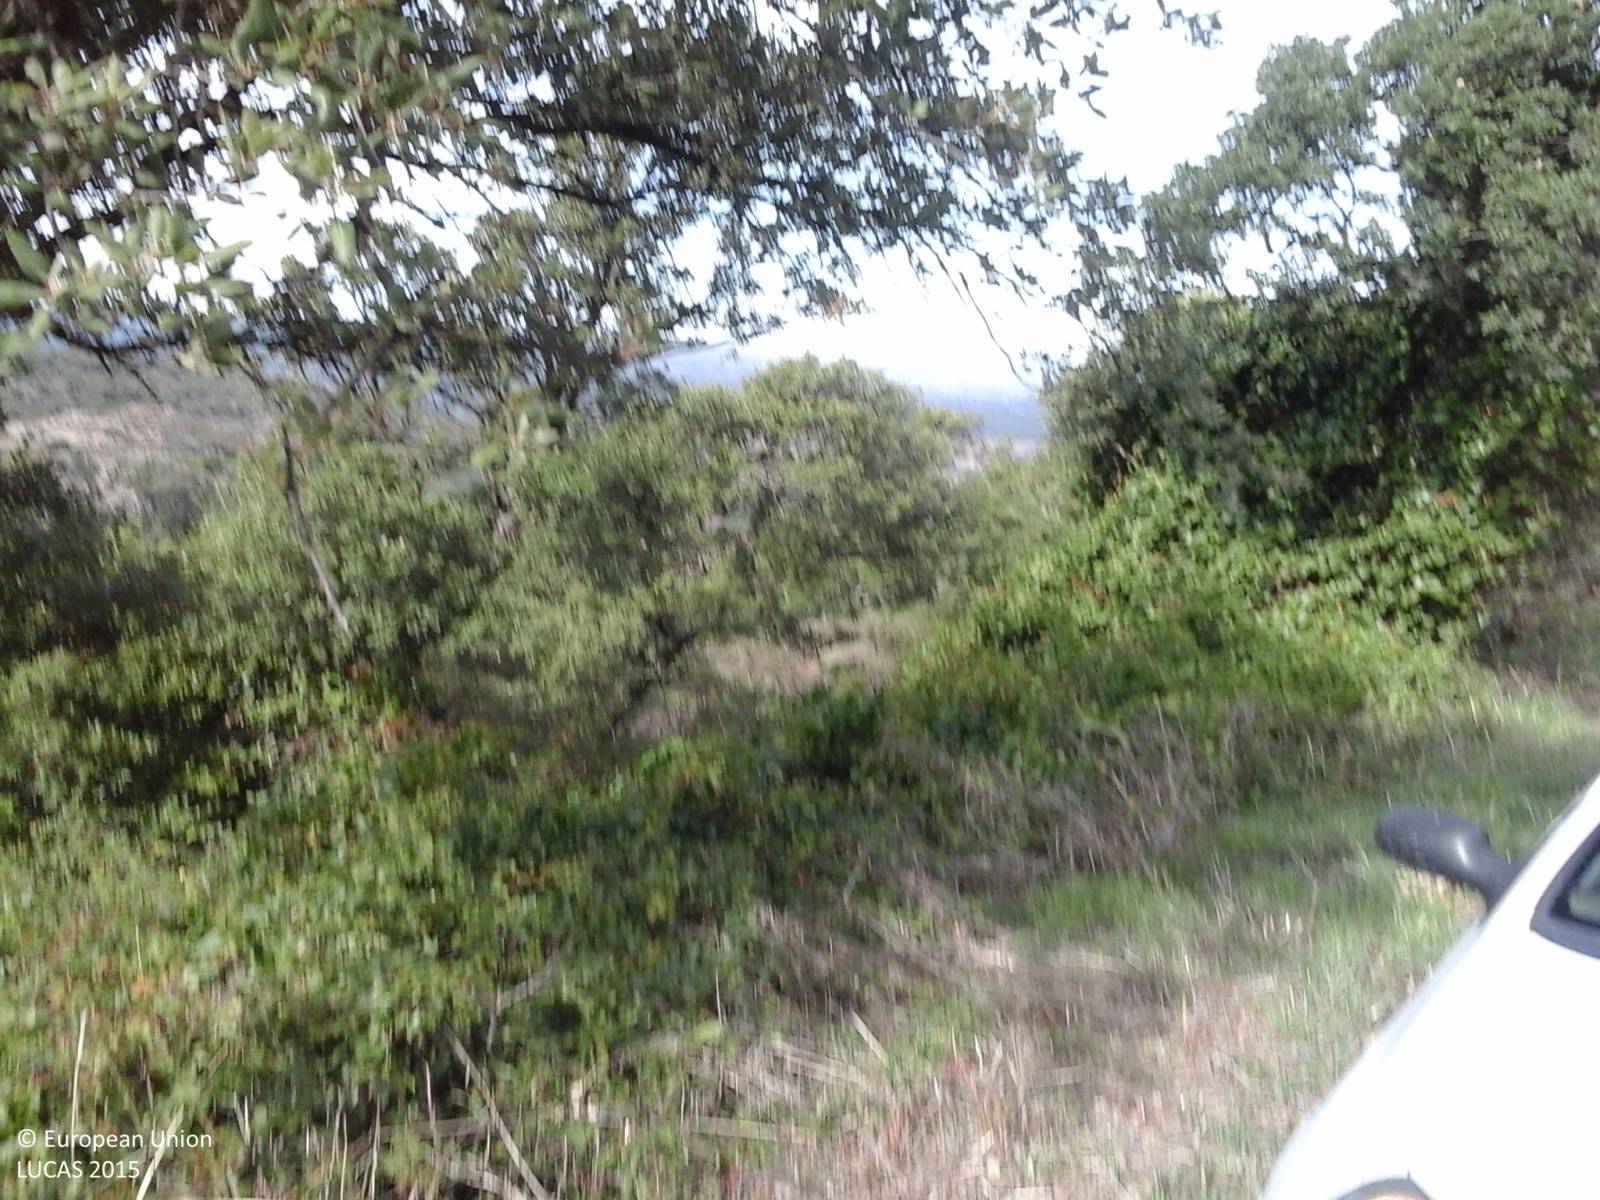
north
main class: Shrubland
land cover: Shrubland with sparse tree cover
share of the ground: > 75 %
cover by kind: shrubs 95 %, broadleaved forest trees 5 %
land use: Semi-natural and natural areas not in use
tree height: < 5 m
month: October
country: IT
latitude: 40.3643
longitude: 8.4886
